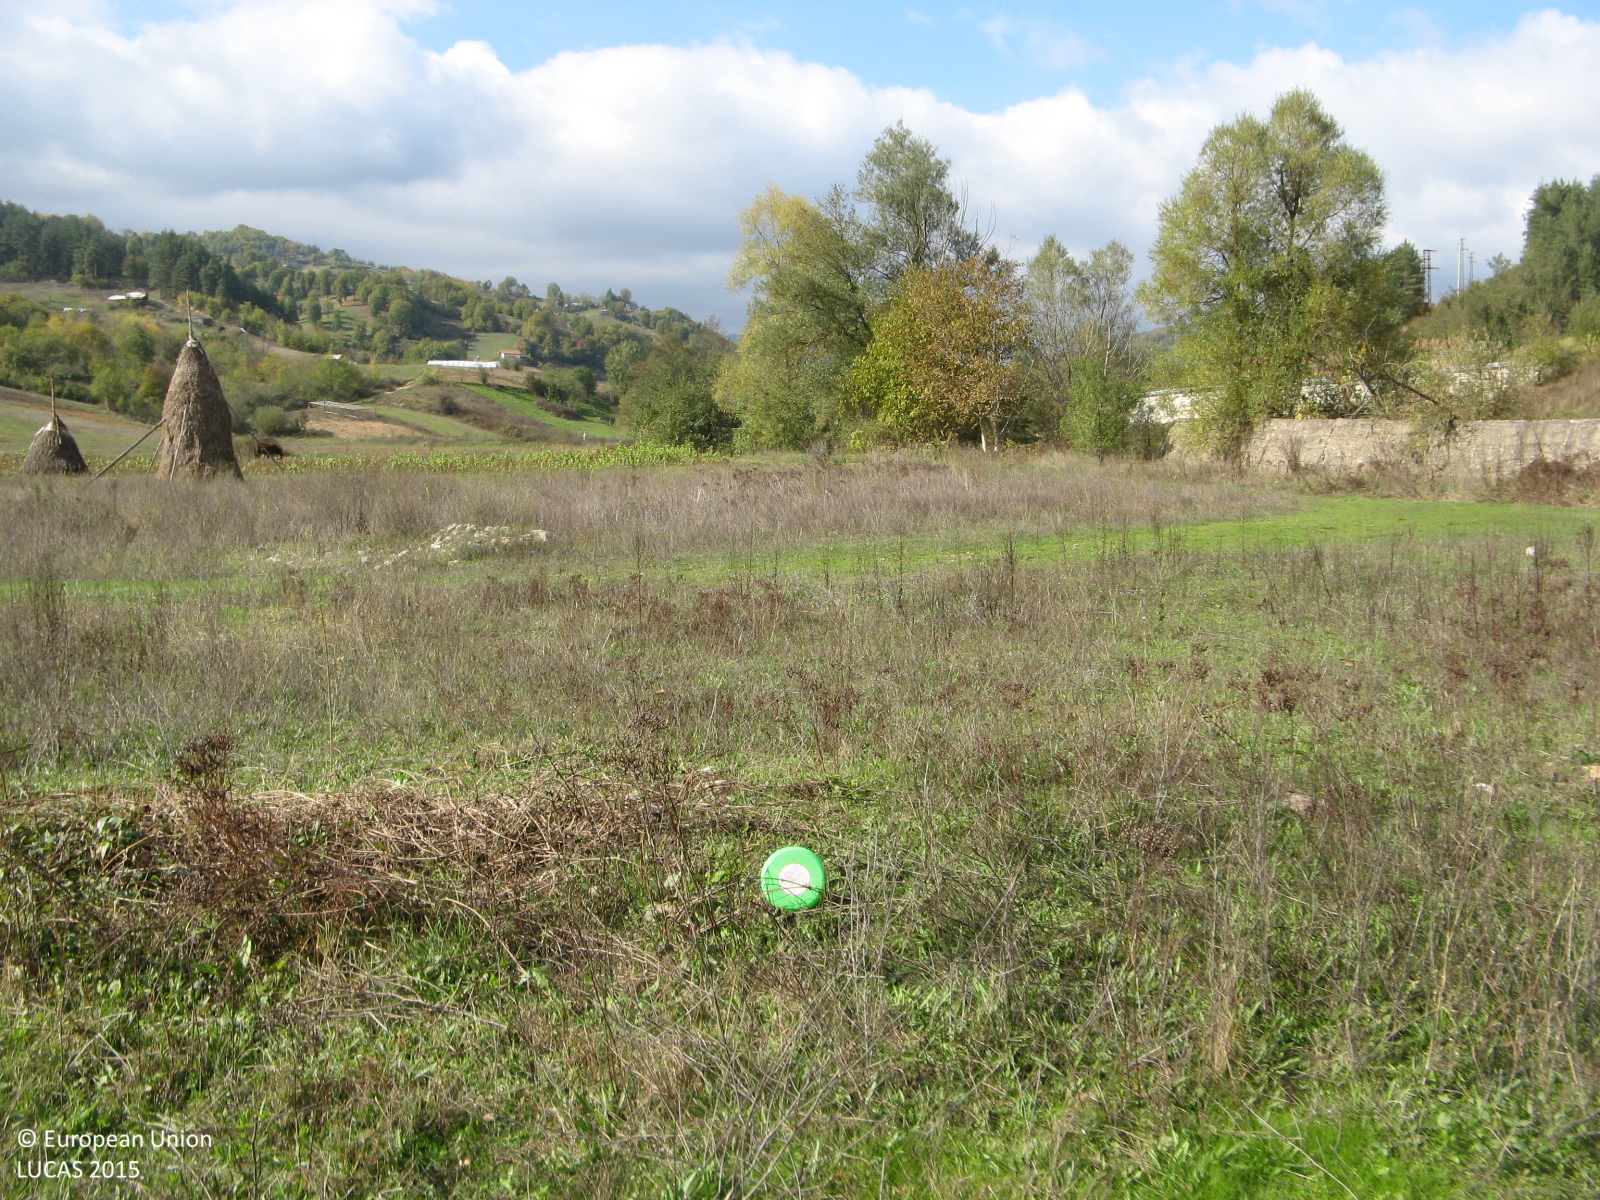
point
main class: Grassland
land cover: Grassland without tree/shrub cover
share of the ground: > 75 %
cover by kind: herbaceous plants 100 %
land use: Agriculture (excluding fallow land and kitchen gardens)
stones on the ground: < 10 %
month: October
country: BG
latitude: 41.4384
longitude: 25.1173
